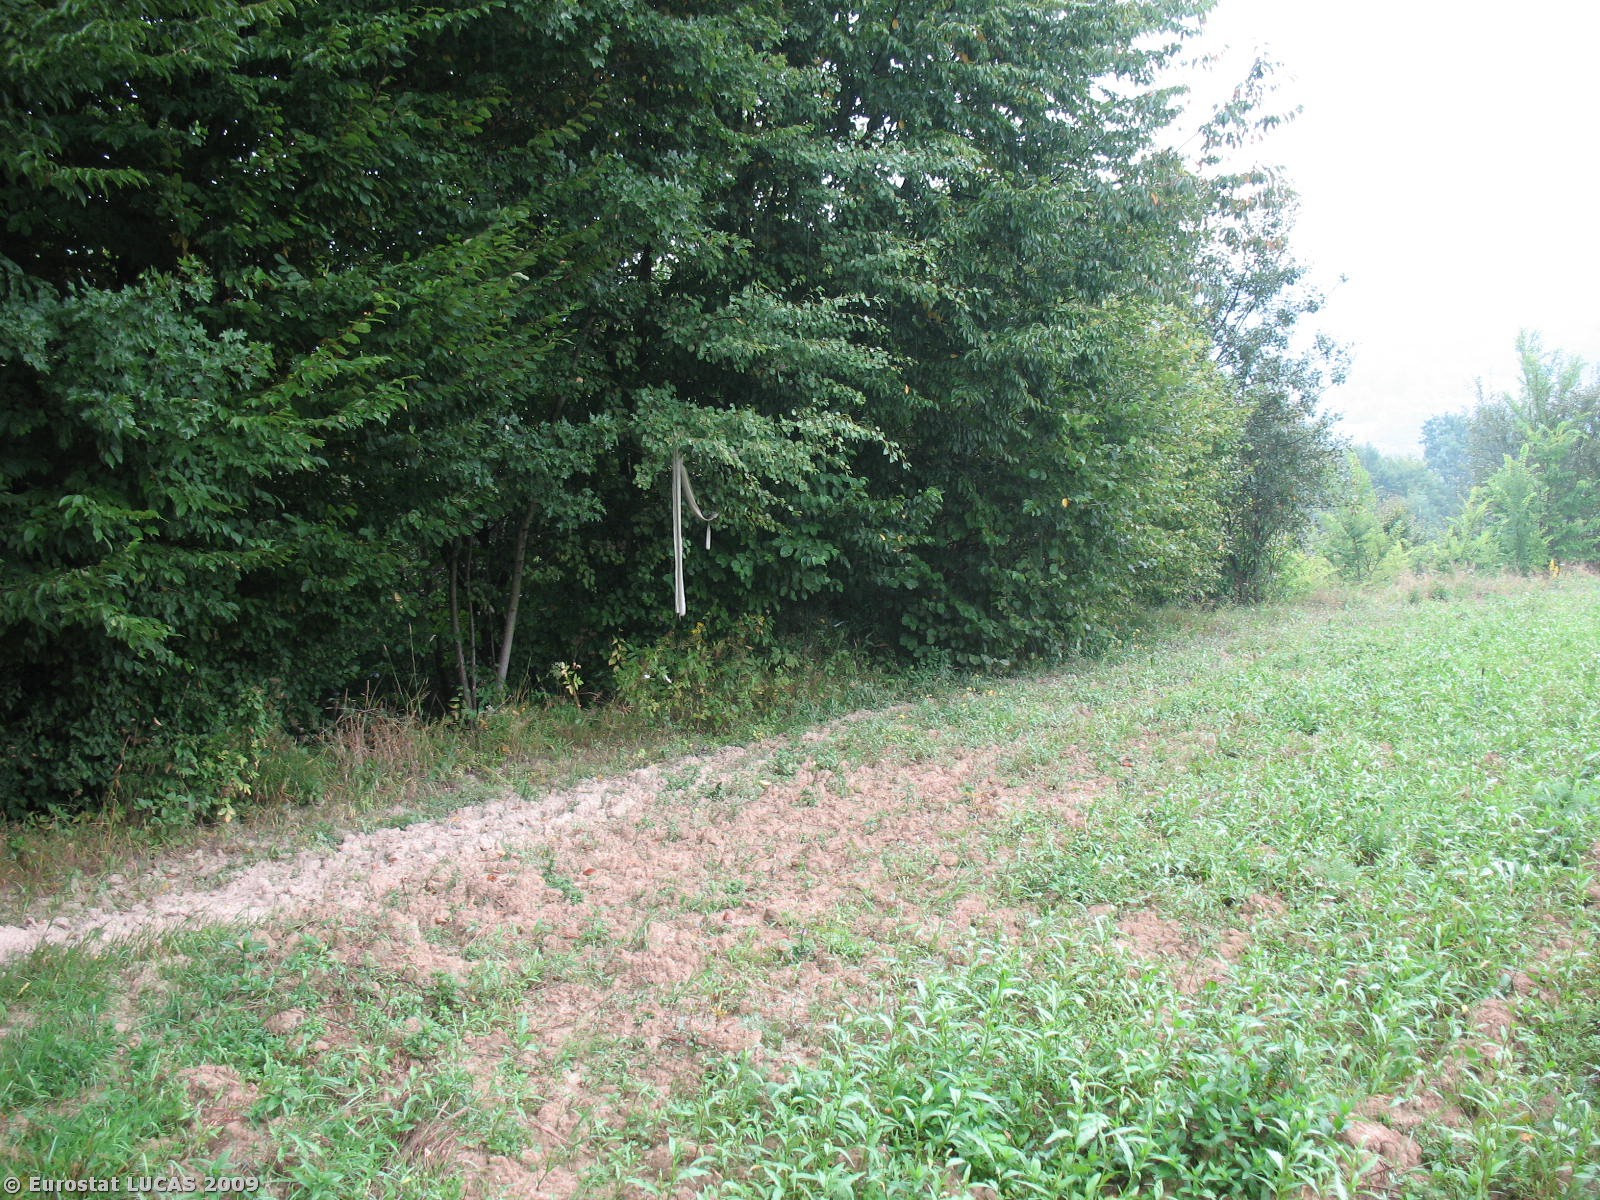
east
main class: Grassland
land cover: Spontaneously vegetated surfaces
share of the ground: > 75 %
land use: Fallow land
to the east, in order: Spontaneously vegetated surfaces; Broadleaved woodland; Spontaneously vegetated surfaces; Tracks; Lines of trees; Grassland with sparse tree/shrub cover
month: August
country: PL
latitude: 49.4076
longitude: 22.2854
